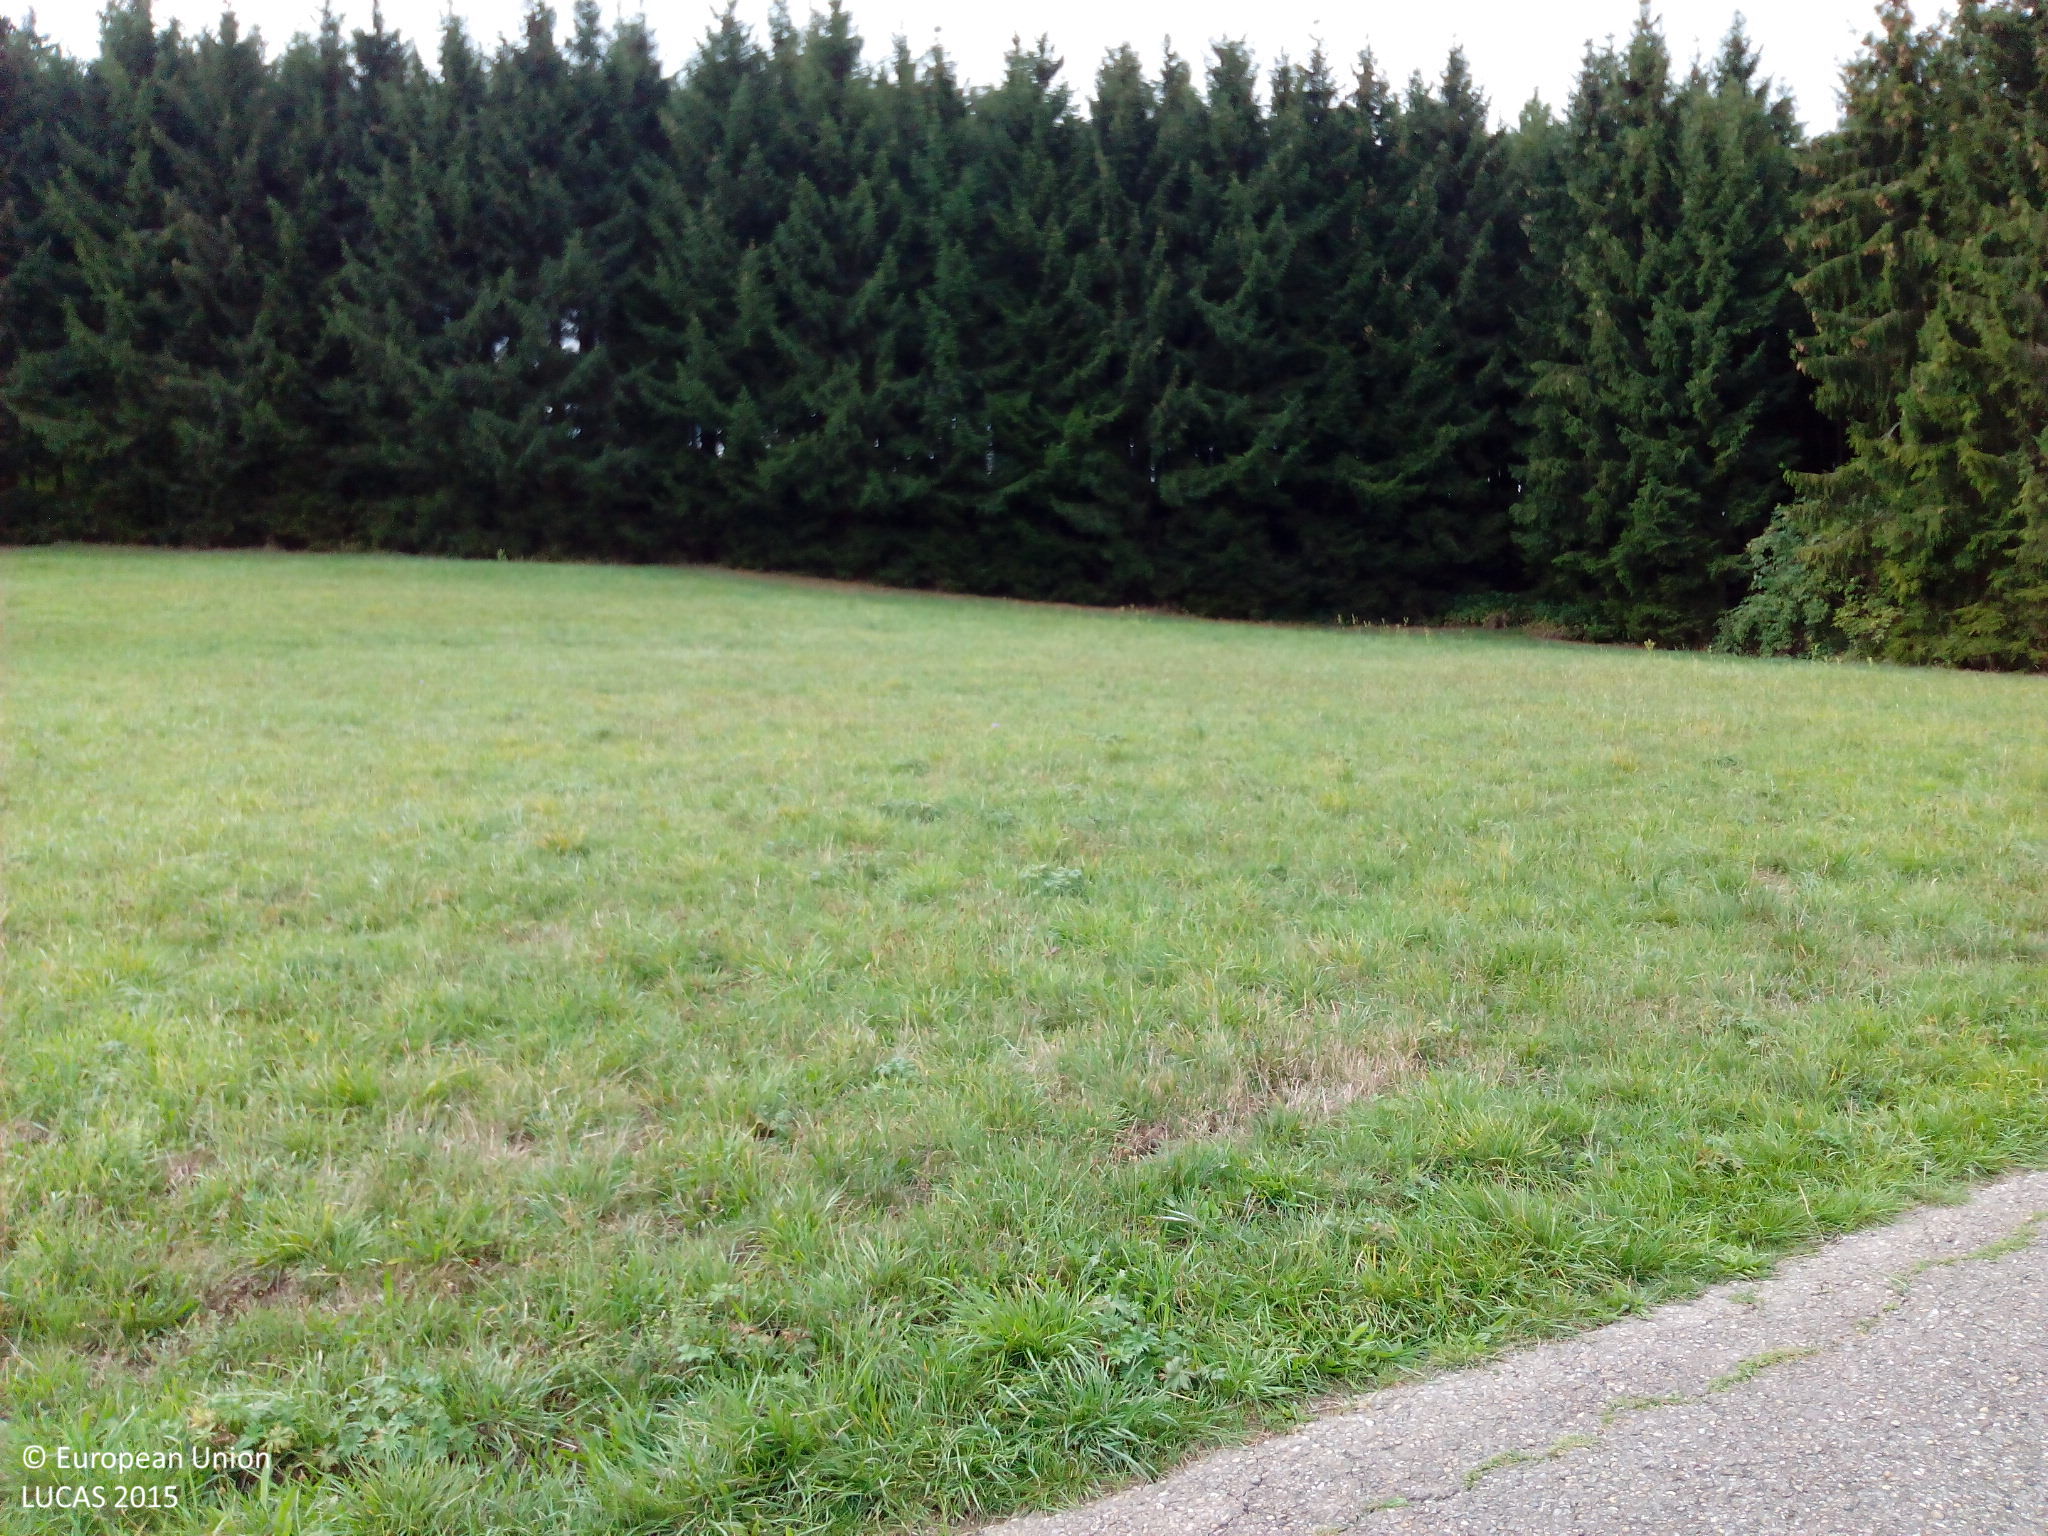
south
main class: Grassland
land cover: Grassland without tree/shrub cover
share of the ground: > 75 %
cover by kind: herbaceous plants 95 %, unconsolidated bare surface 5 %
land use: Agriculture (excluding fallow land and kitchen gardens)
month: September
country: DE
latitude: 48.2341
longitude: 8.7217
